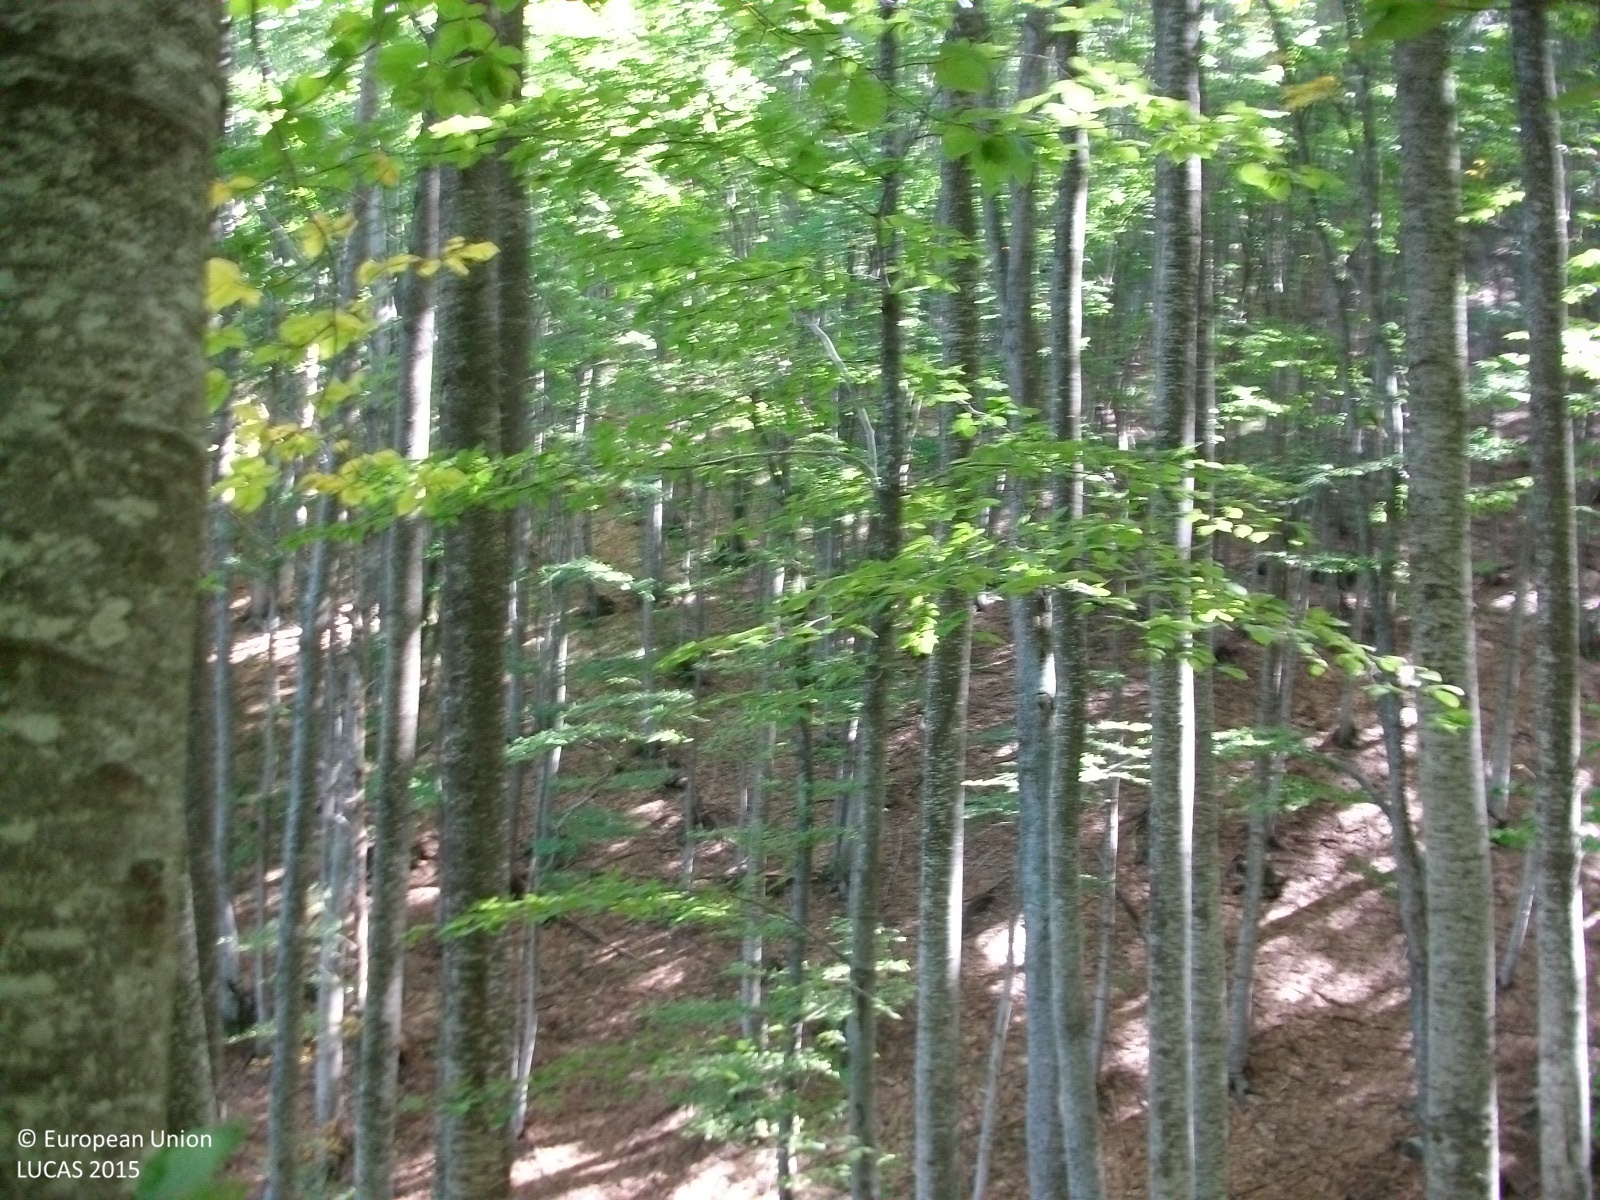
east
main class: Woodland
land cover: Broadleaved woodland
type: mountainous beech forest
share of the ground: > 75 %
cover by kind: broadleaved forest trees 85 %, herbaceous plants 15 %
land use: Forestry
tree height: > 5 m
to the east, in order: Broadleaved woodland; Rivers and streams; Broadleaved woodland
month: September
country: GR
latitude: 40.7022
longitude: 21.3425
